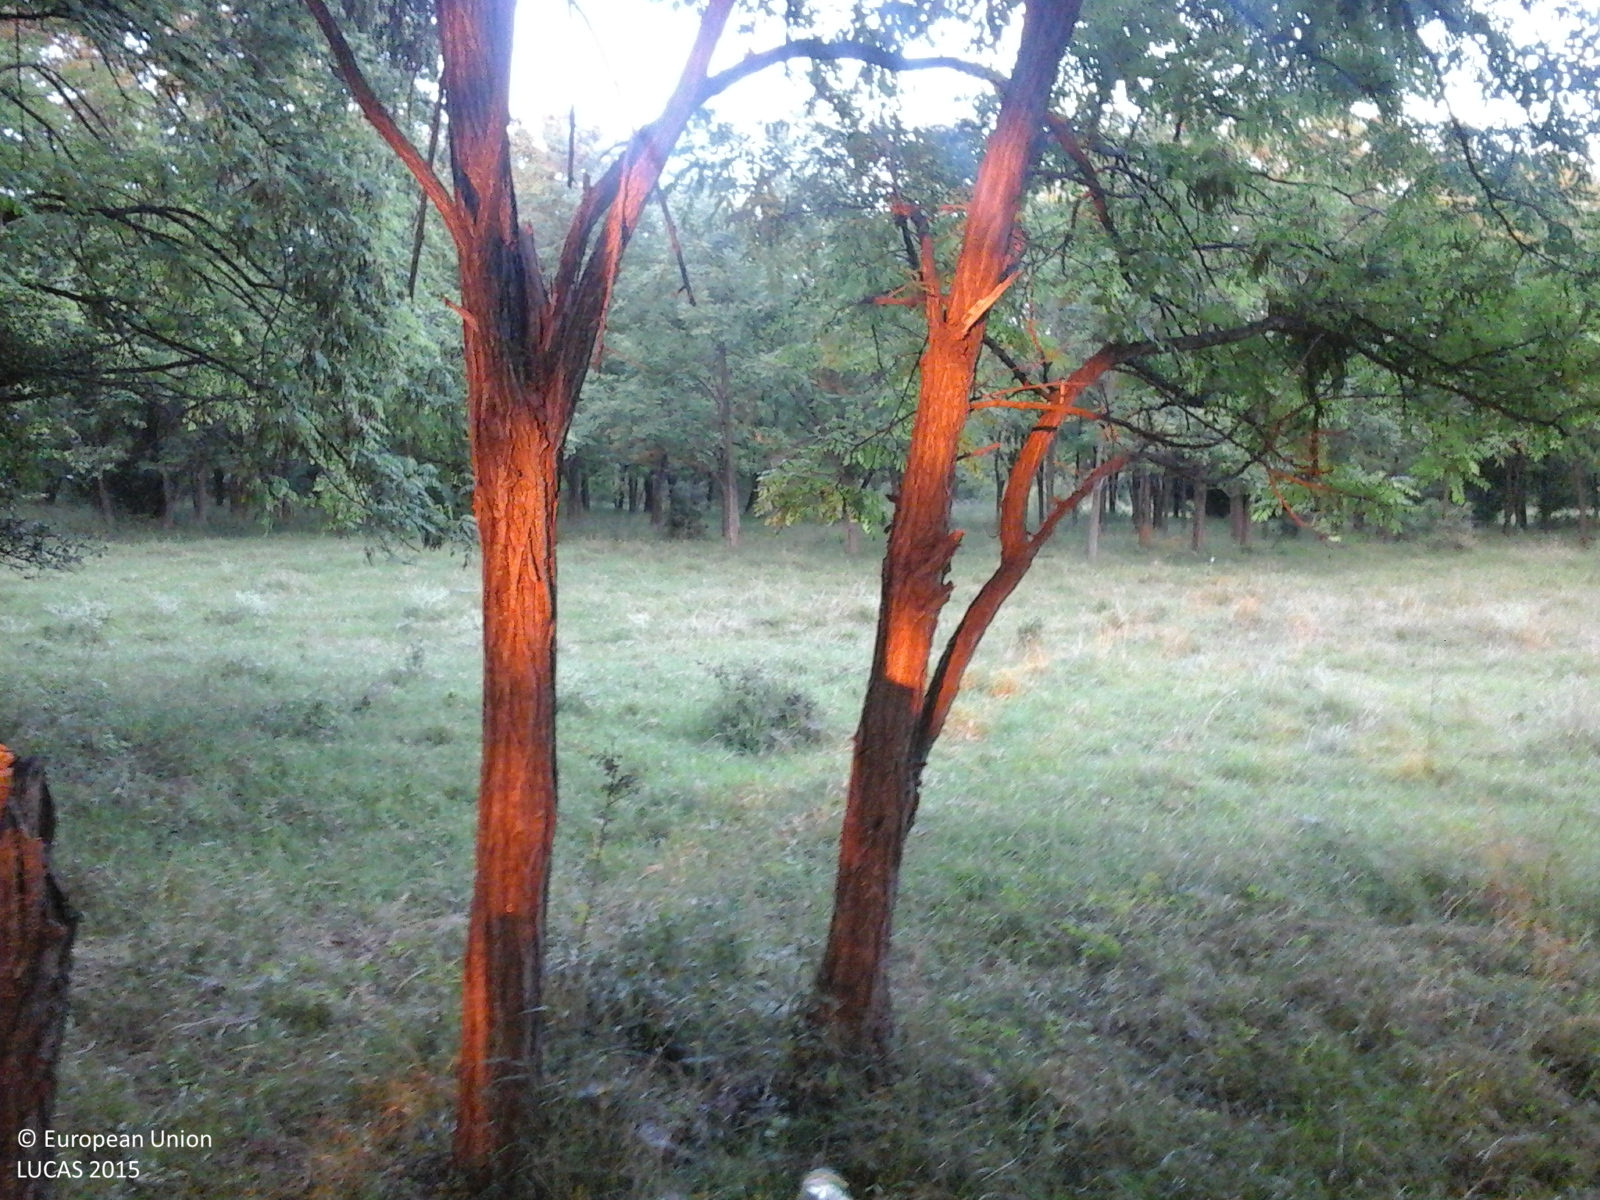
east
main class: Woodland
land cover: Broadleaved woodland
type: exotic forest
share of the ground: > 75 %
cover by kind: broadleaved forest trees 80 %, herbaceous plants 20 %
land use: Forestry
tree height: > 5 m
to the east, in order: Broadleaved woodland; Grassland with sparse tree/shrub cover; Broadleaved woodland; Grassland with sparse tree/shrub cover
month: July
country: RO
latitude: 43.8908
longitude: 24.6449
